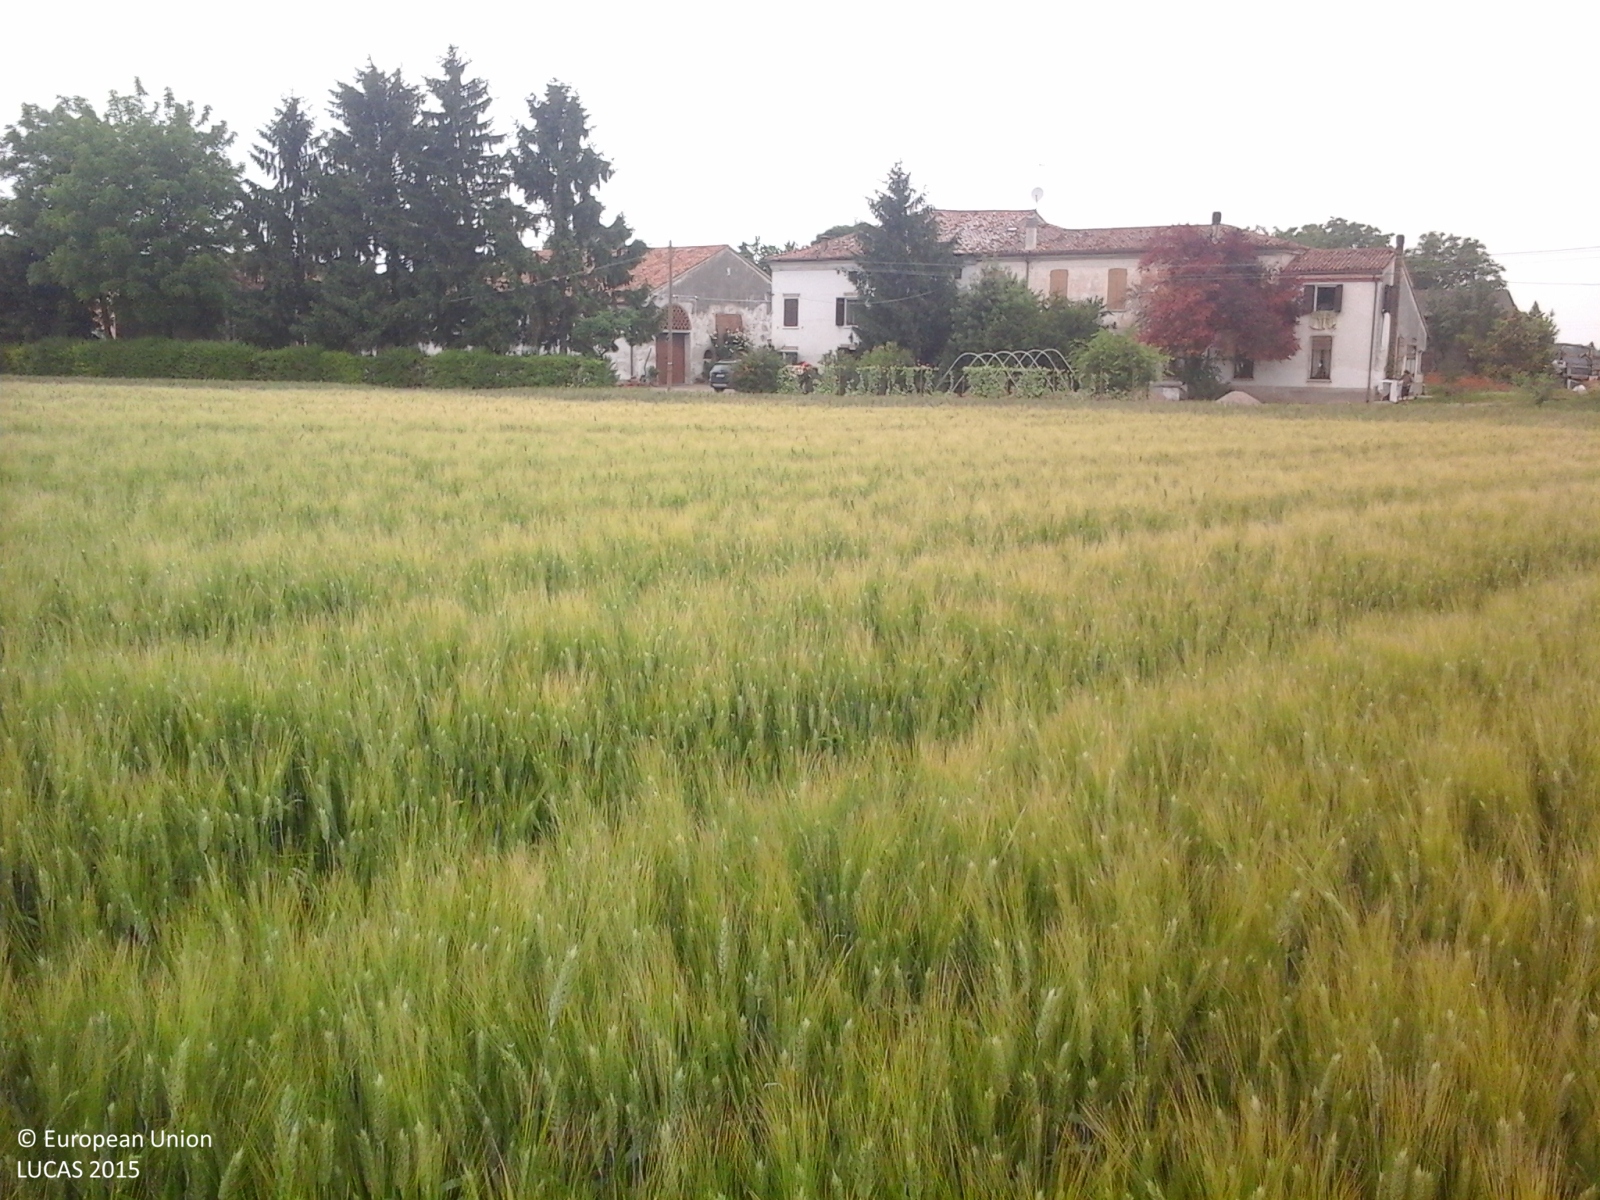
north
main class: Cropland
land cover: Common wheat
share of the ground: > 75 %
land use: Agriculture (excluding fallow land and kitchen gardens)
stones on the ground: < 10 %
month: May
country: IT
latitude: 45.1416
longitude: 10.6981
